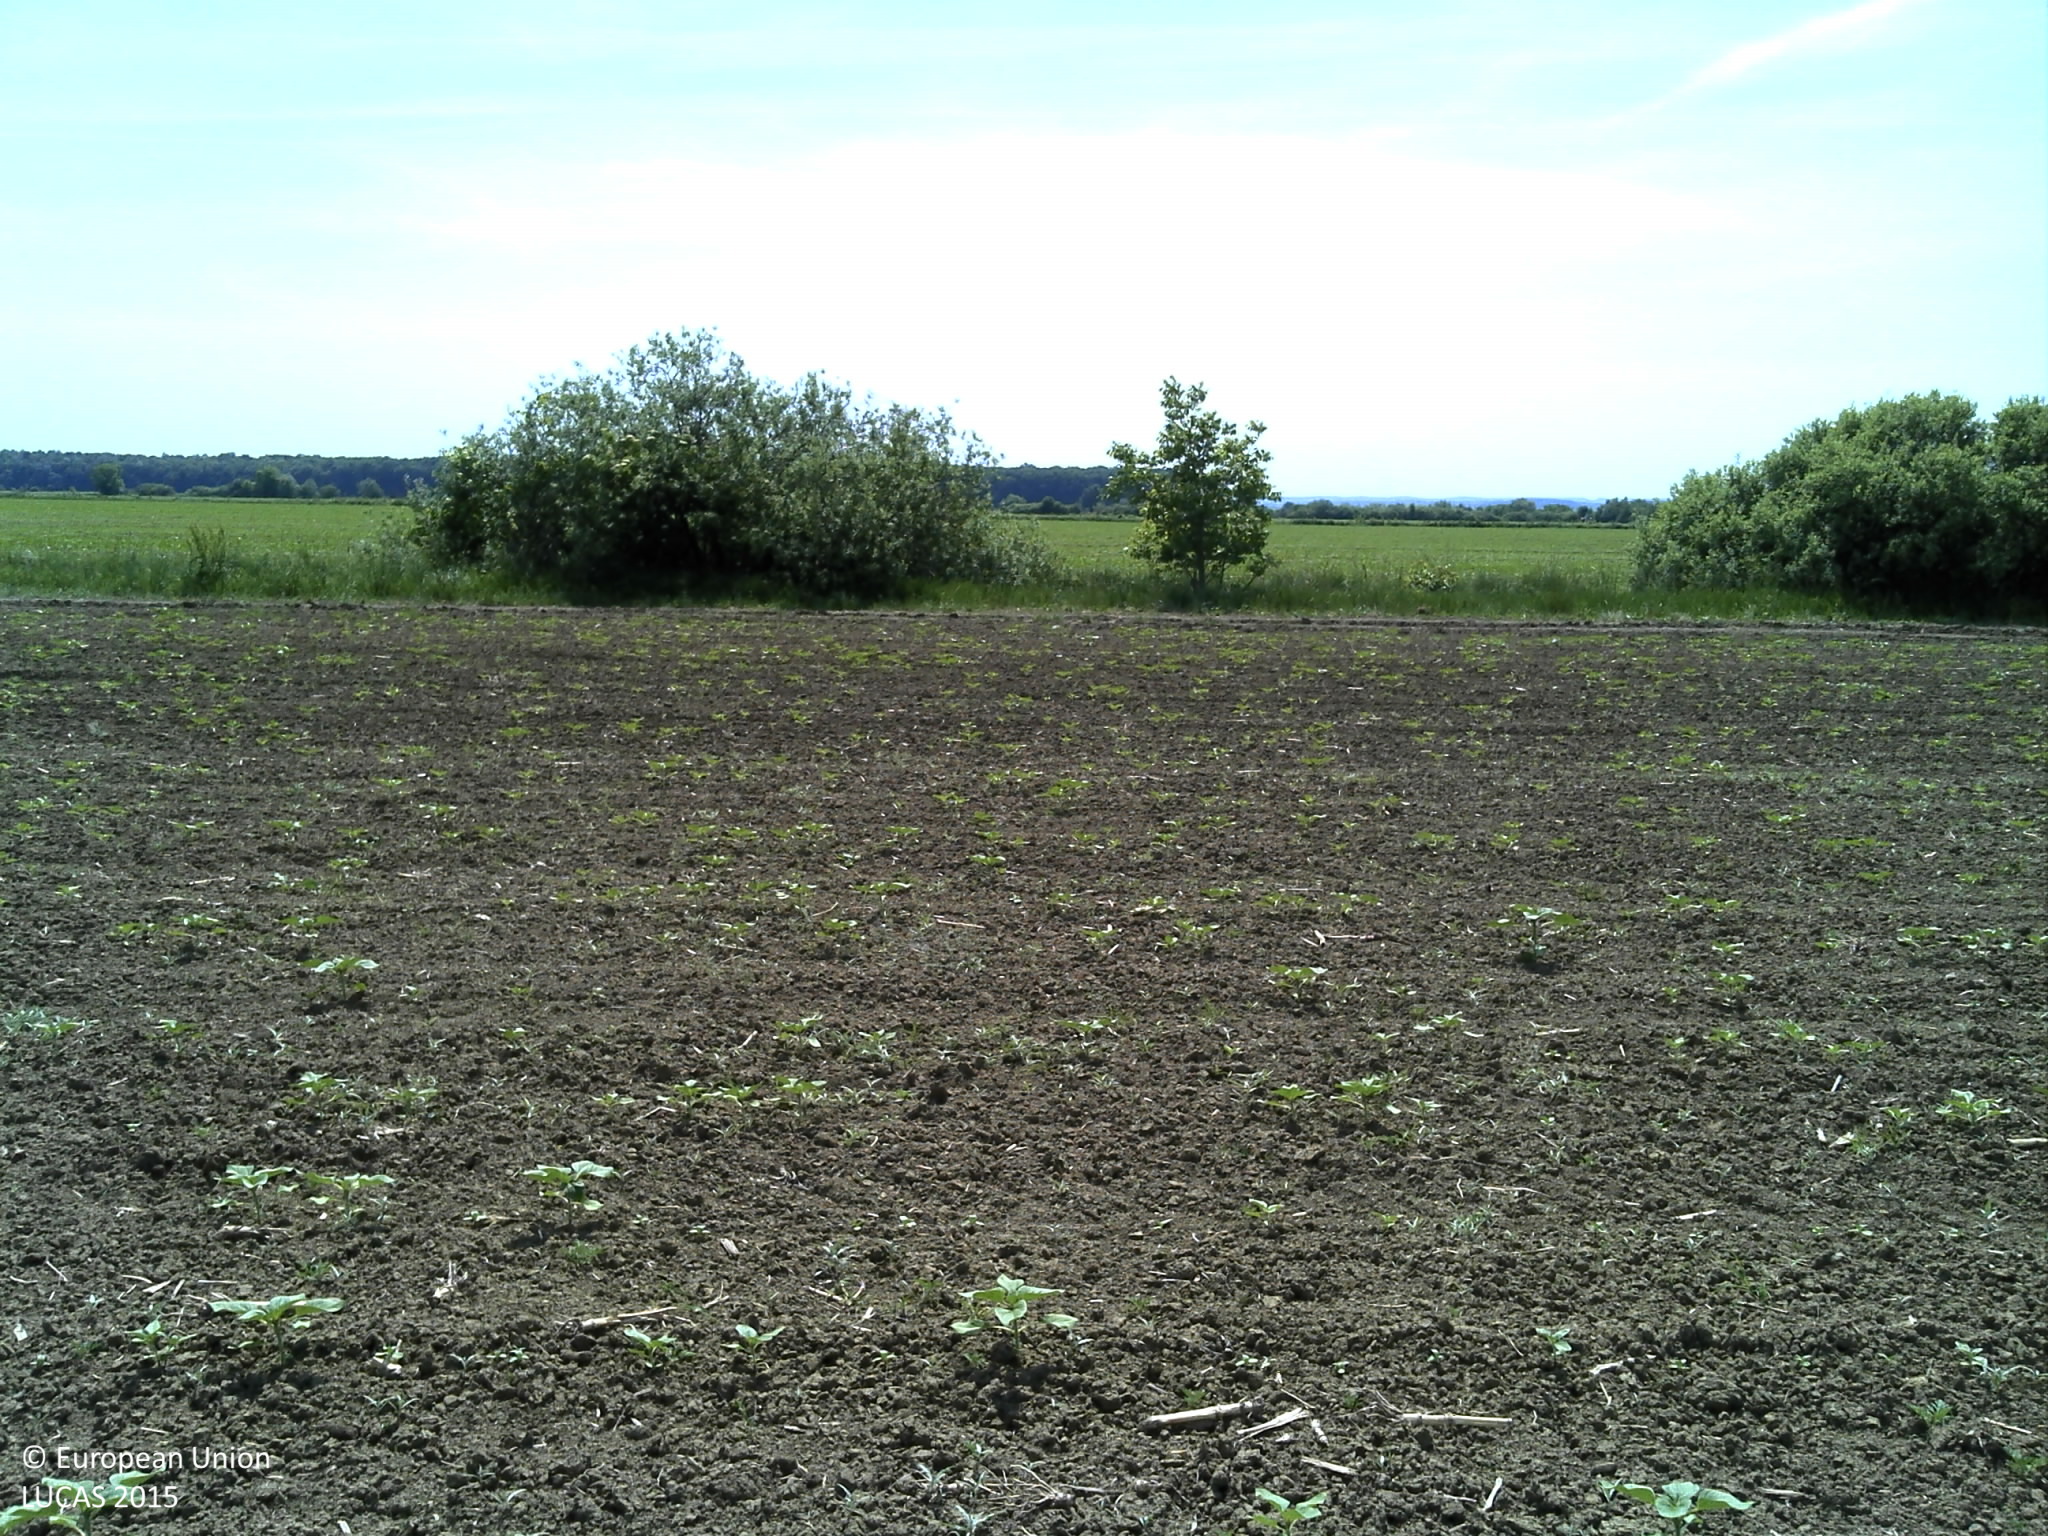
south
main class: Cropland
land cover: Soya
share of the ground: < 10 %
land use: Agriculture (excluding fallow land and kitchen gardens)
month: May
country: HR
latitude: 45.5301
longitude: 18.1868
